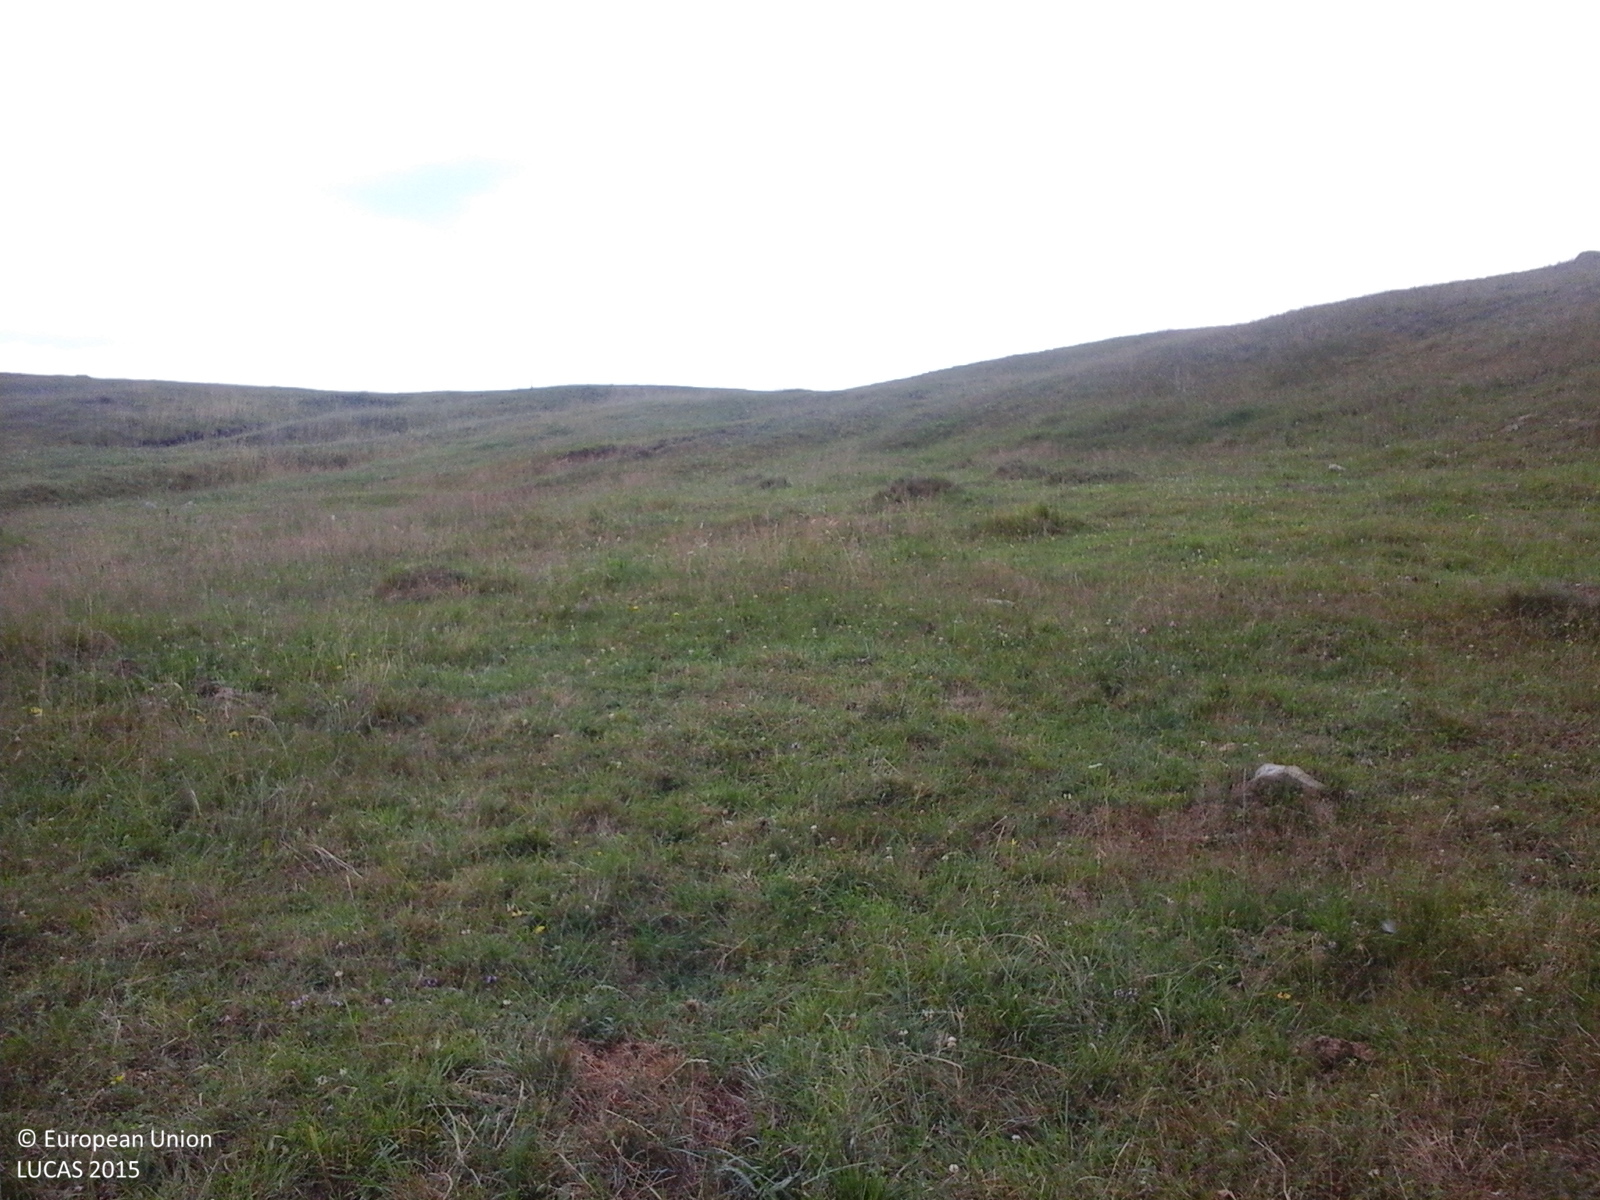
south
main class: Grassland
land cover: Grassland without tree/shrub cover
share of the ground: > 75 %
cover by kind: herbaceous plants 100 %
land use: Agriculture (excluding fallow land and kitchen gardens)
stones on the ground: < 10 %
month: July
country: RO
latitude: 45.2806
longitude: 24.6520
